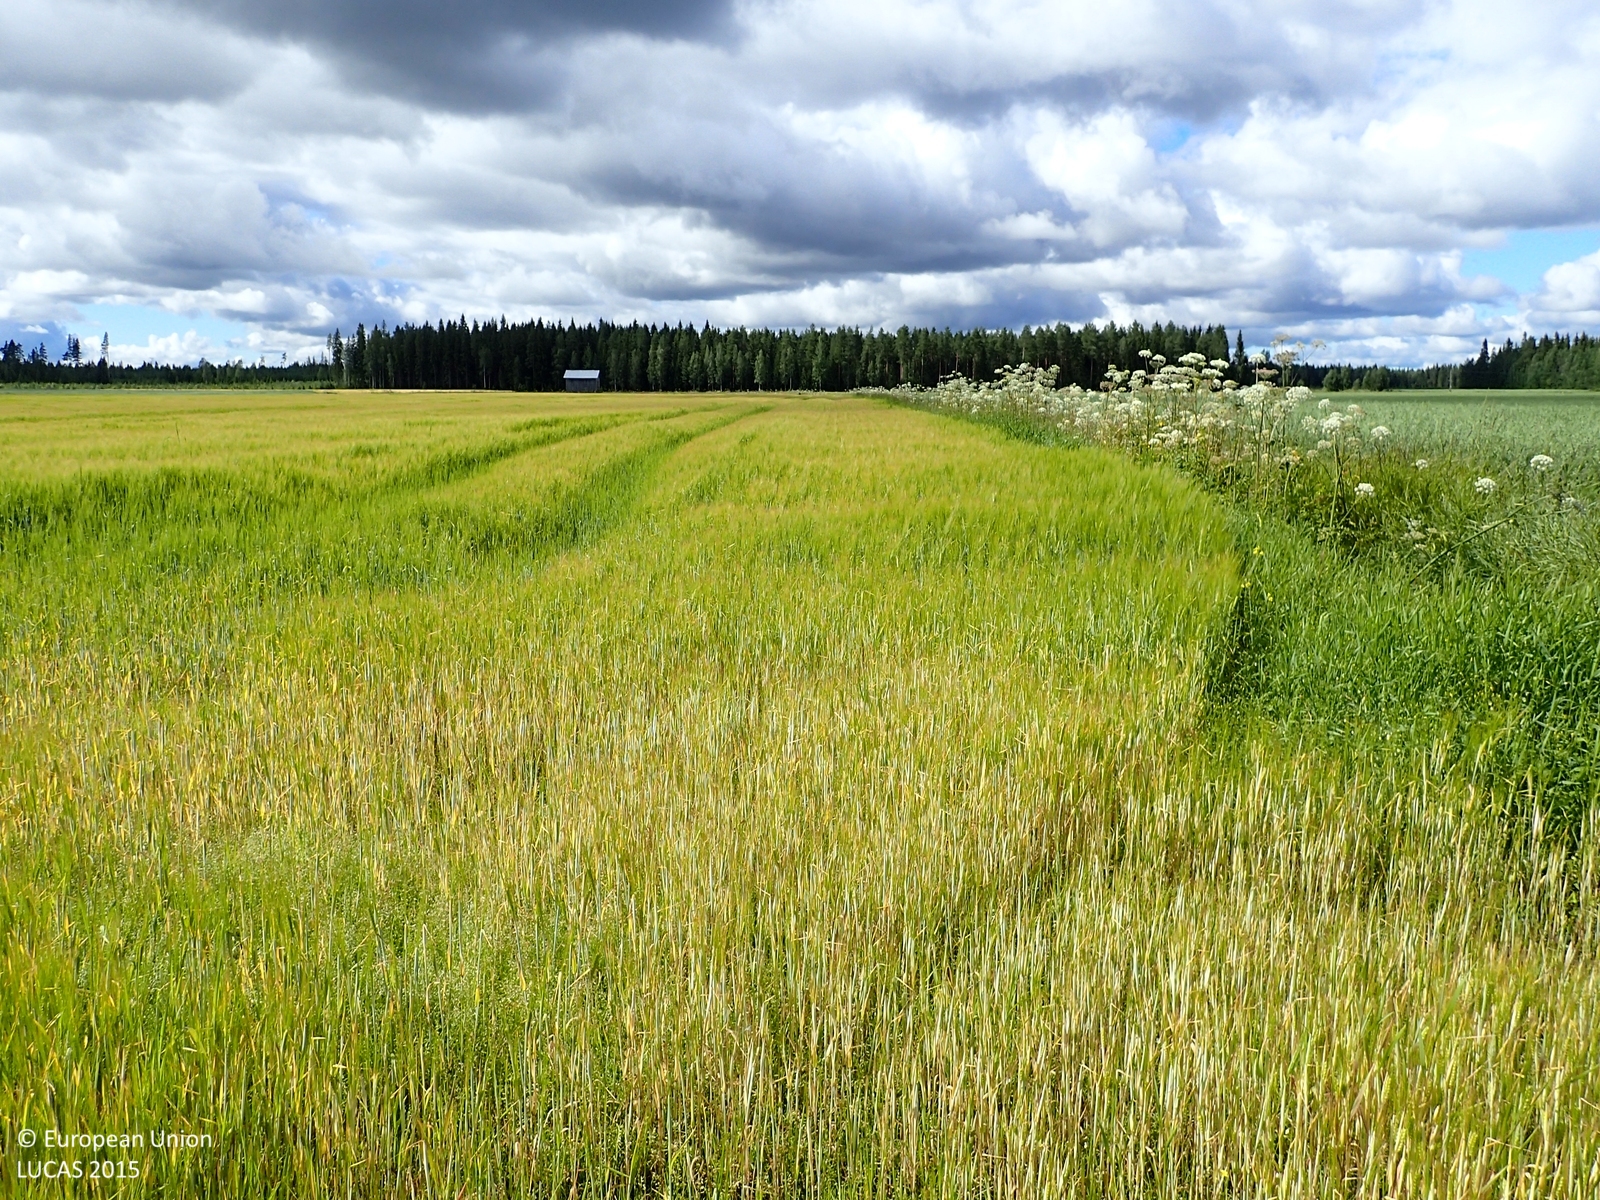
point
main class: Cropland
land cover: Barley
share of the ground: > 75 %
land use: Agriculture (excluding fallow land and kitchen gardens)
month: August
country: FI
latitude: 62.6572
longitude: 21.8134
